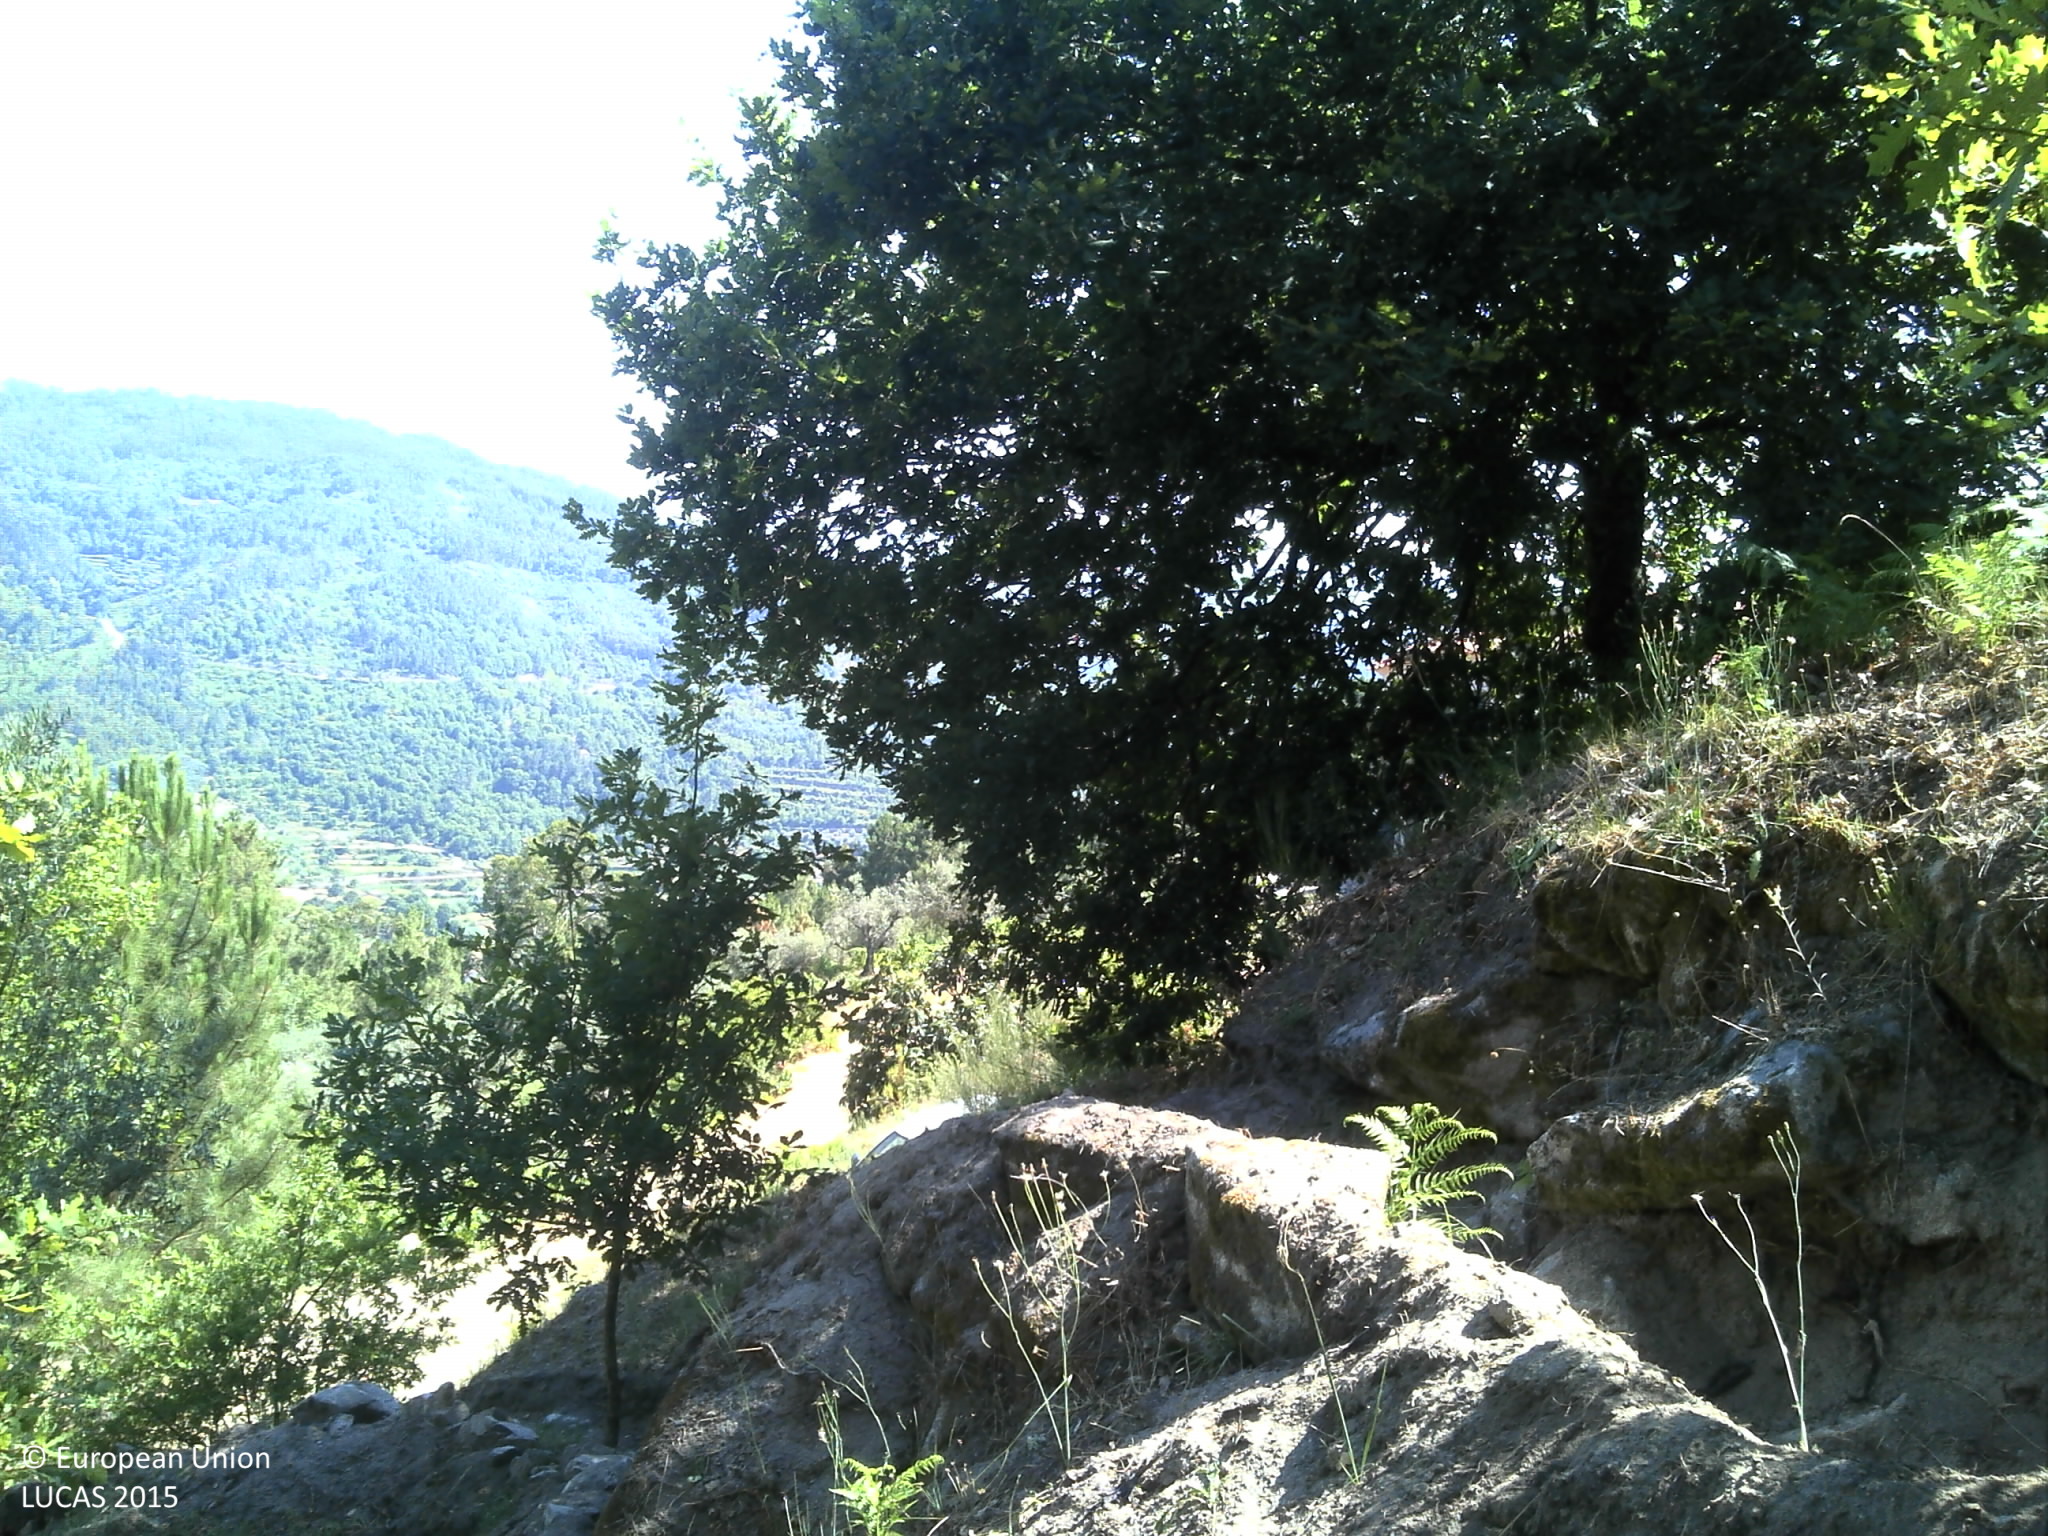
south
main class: Woodland
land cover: Broadleaved woodland
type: thermophilous deciduous forest
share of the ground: 25 - 50 %
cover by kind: broadleaved forest trees 45 %, herbaceous plants 40 %, consolidated bare surface 10 %, shrubs 5 %
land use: Forestry
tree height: < 5 m
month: July
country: PT
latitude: 40.3062
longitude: -7.8962
